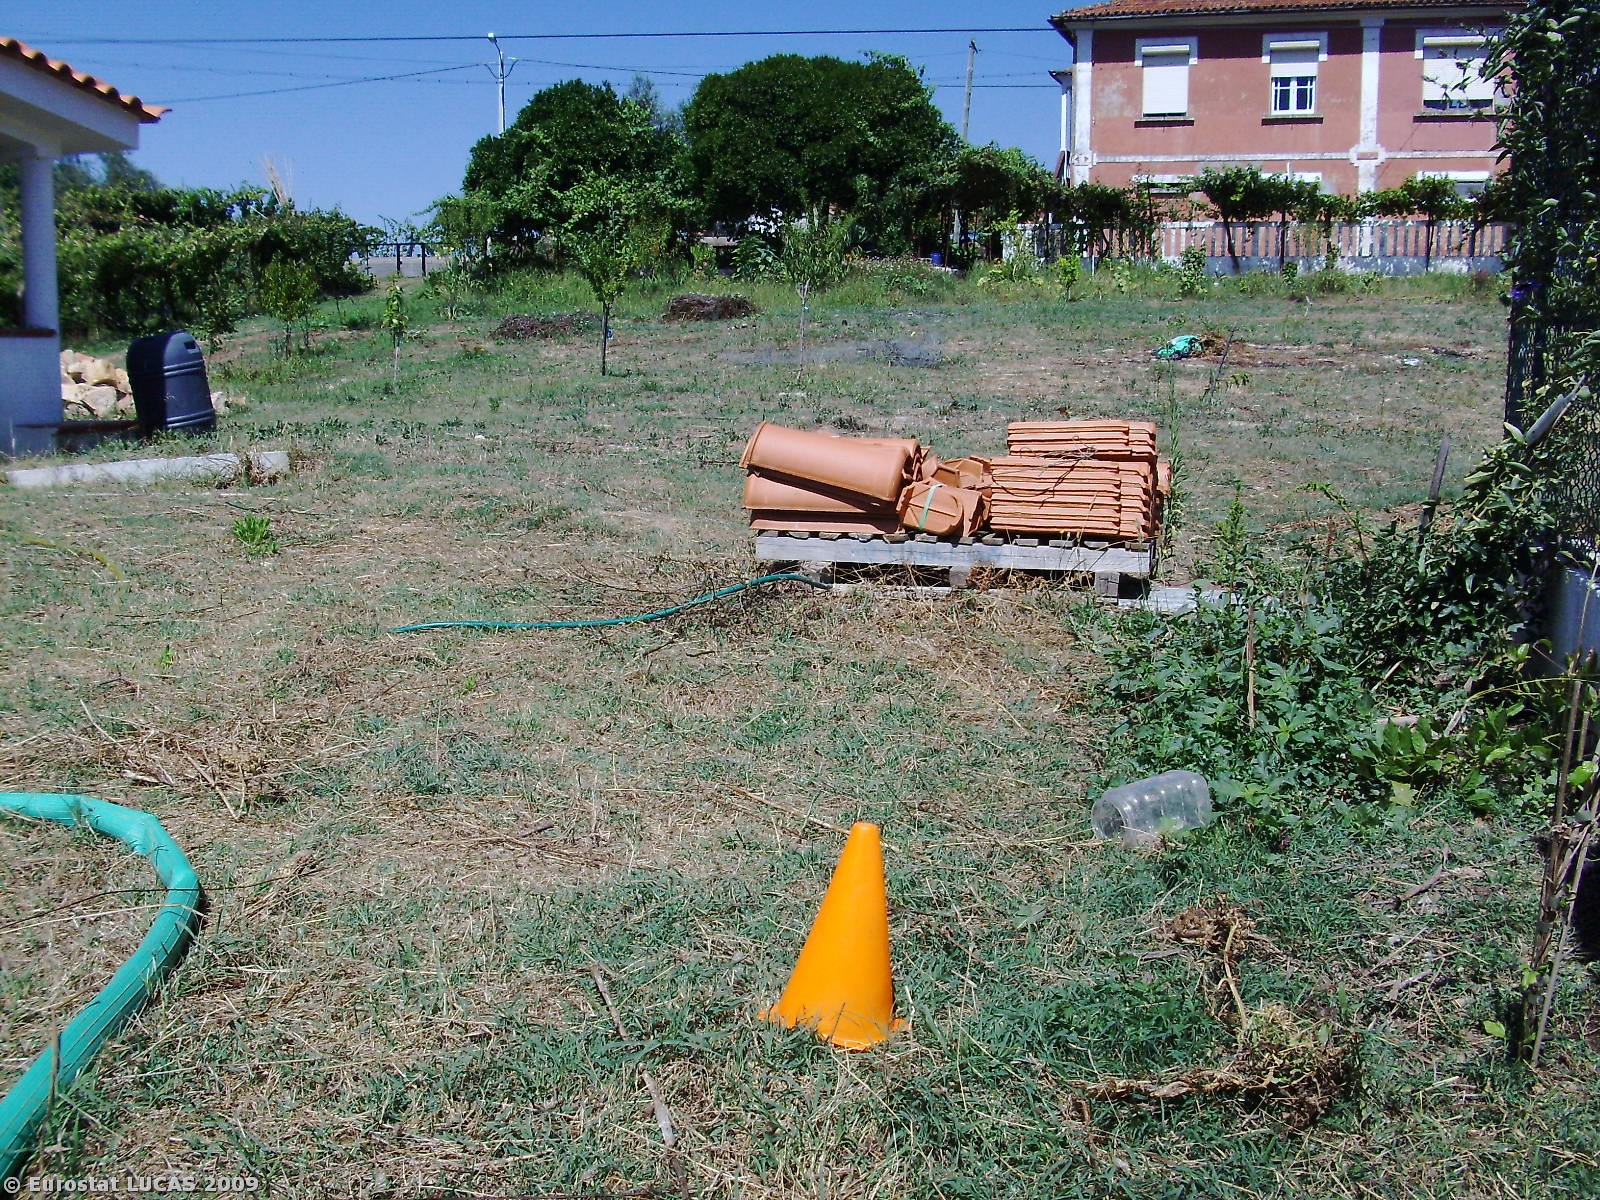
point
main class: Grassland
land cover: Spontaneously vegetated surfaces
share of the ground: > 75 %
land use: Fallow land
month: August
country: PT
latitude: 40.1894
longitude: -8.2248
